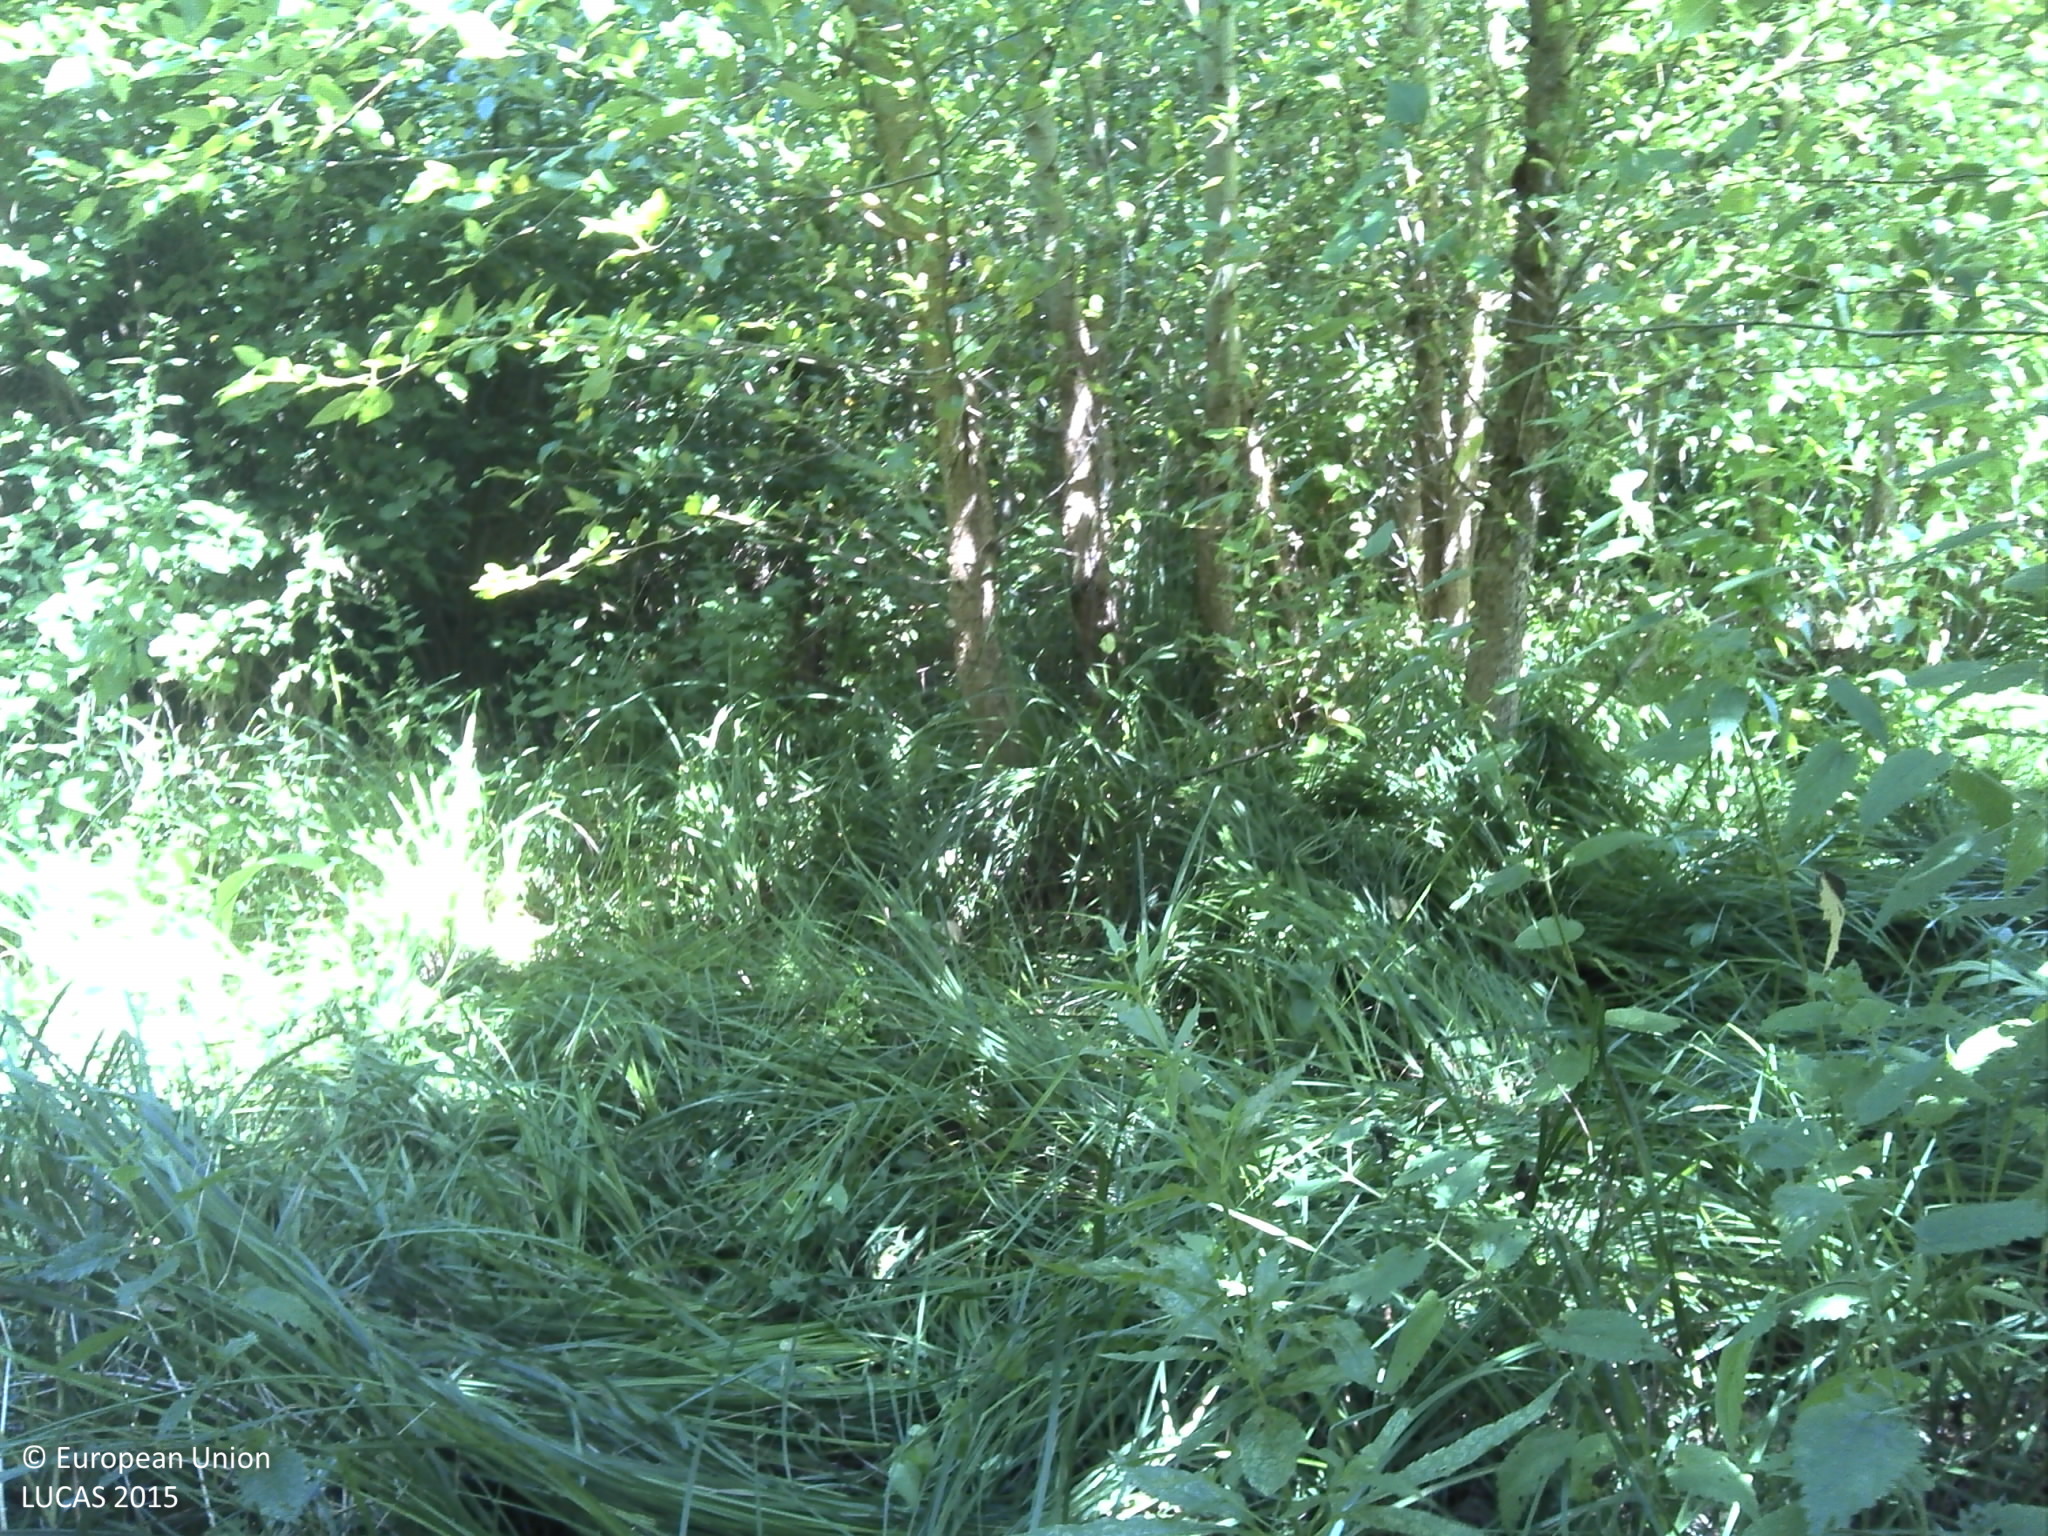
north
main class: Woodland
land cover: Broadleaved woodland
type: floodplain forest
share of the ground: > 75 %
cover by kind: broadleaved forest trees 70 %, herbaceous plants 20 %, shrubs 10 %
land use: Forestry
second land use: Amenities, museums, leisure
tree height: > 5 m
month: July
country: FR
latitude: 48.5260
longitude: 1.9566
